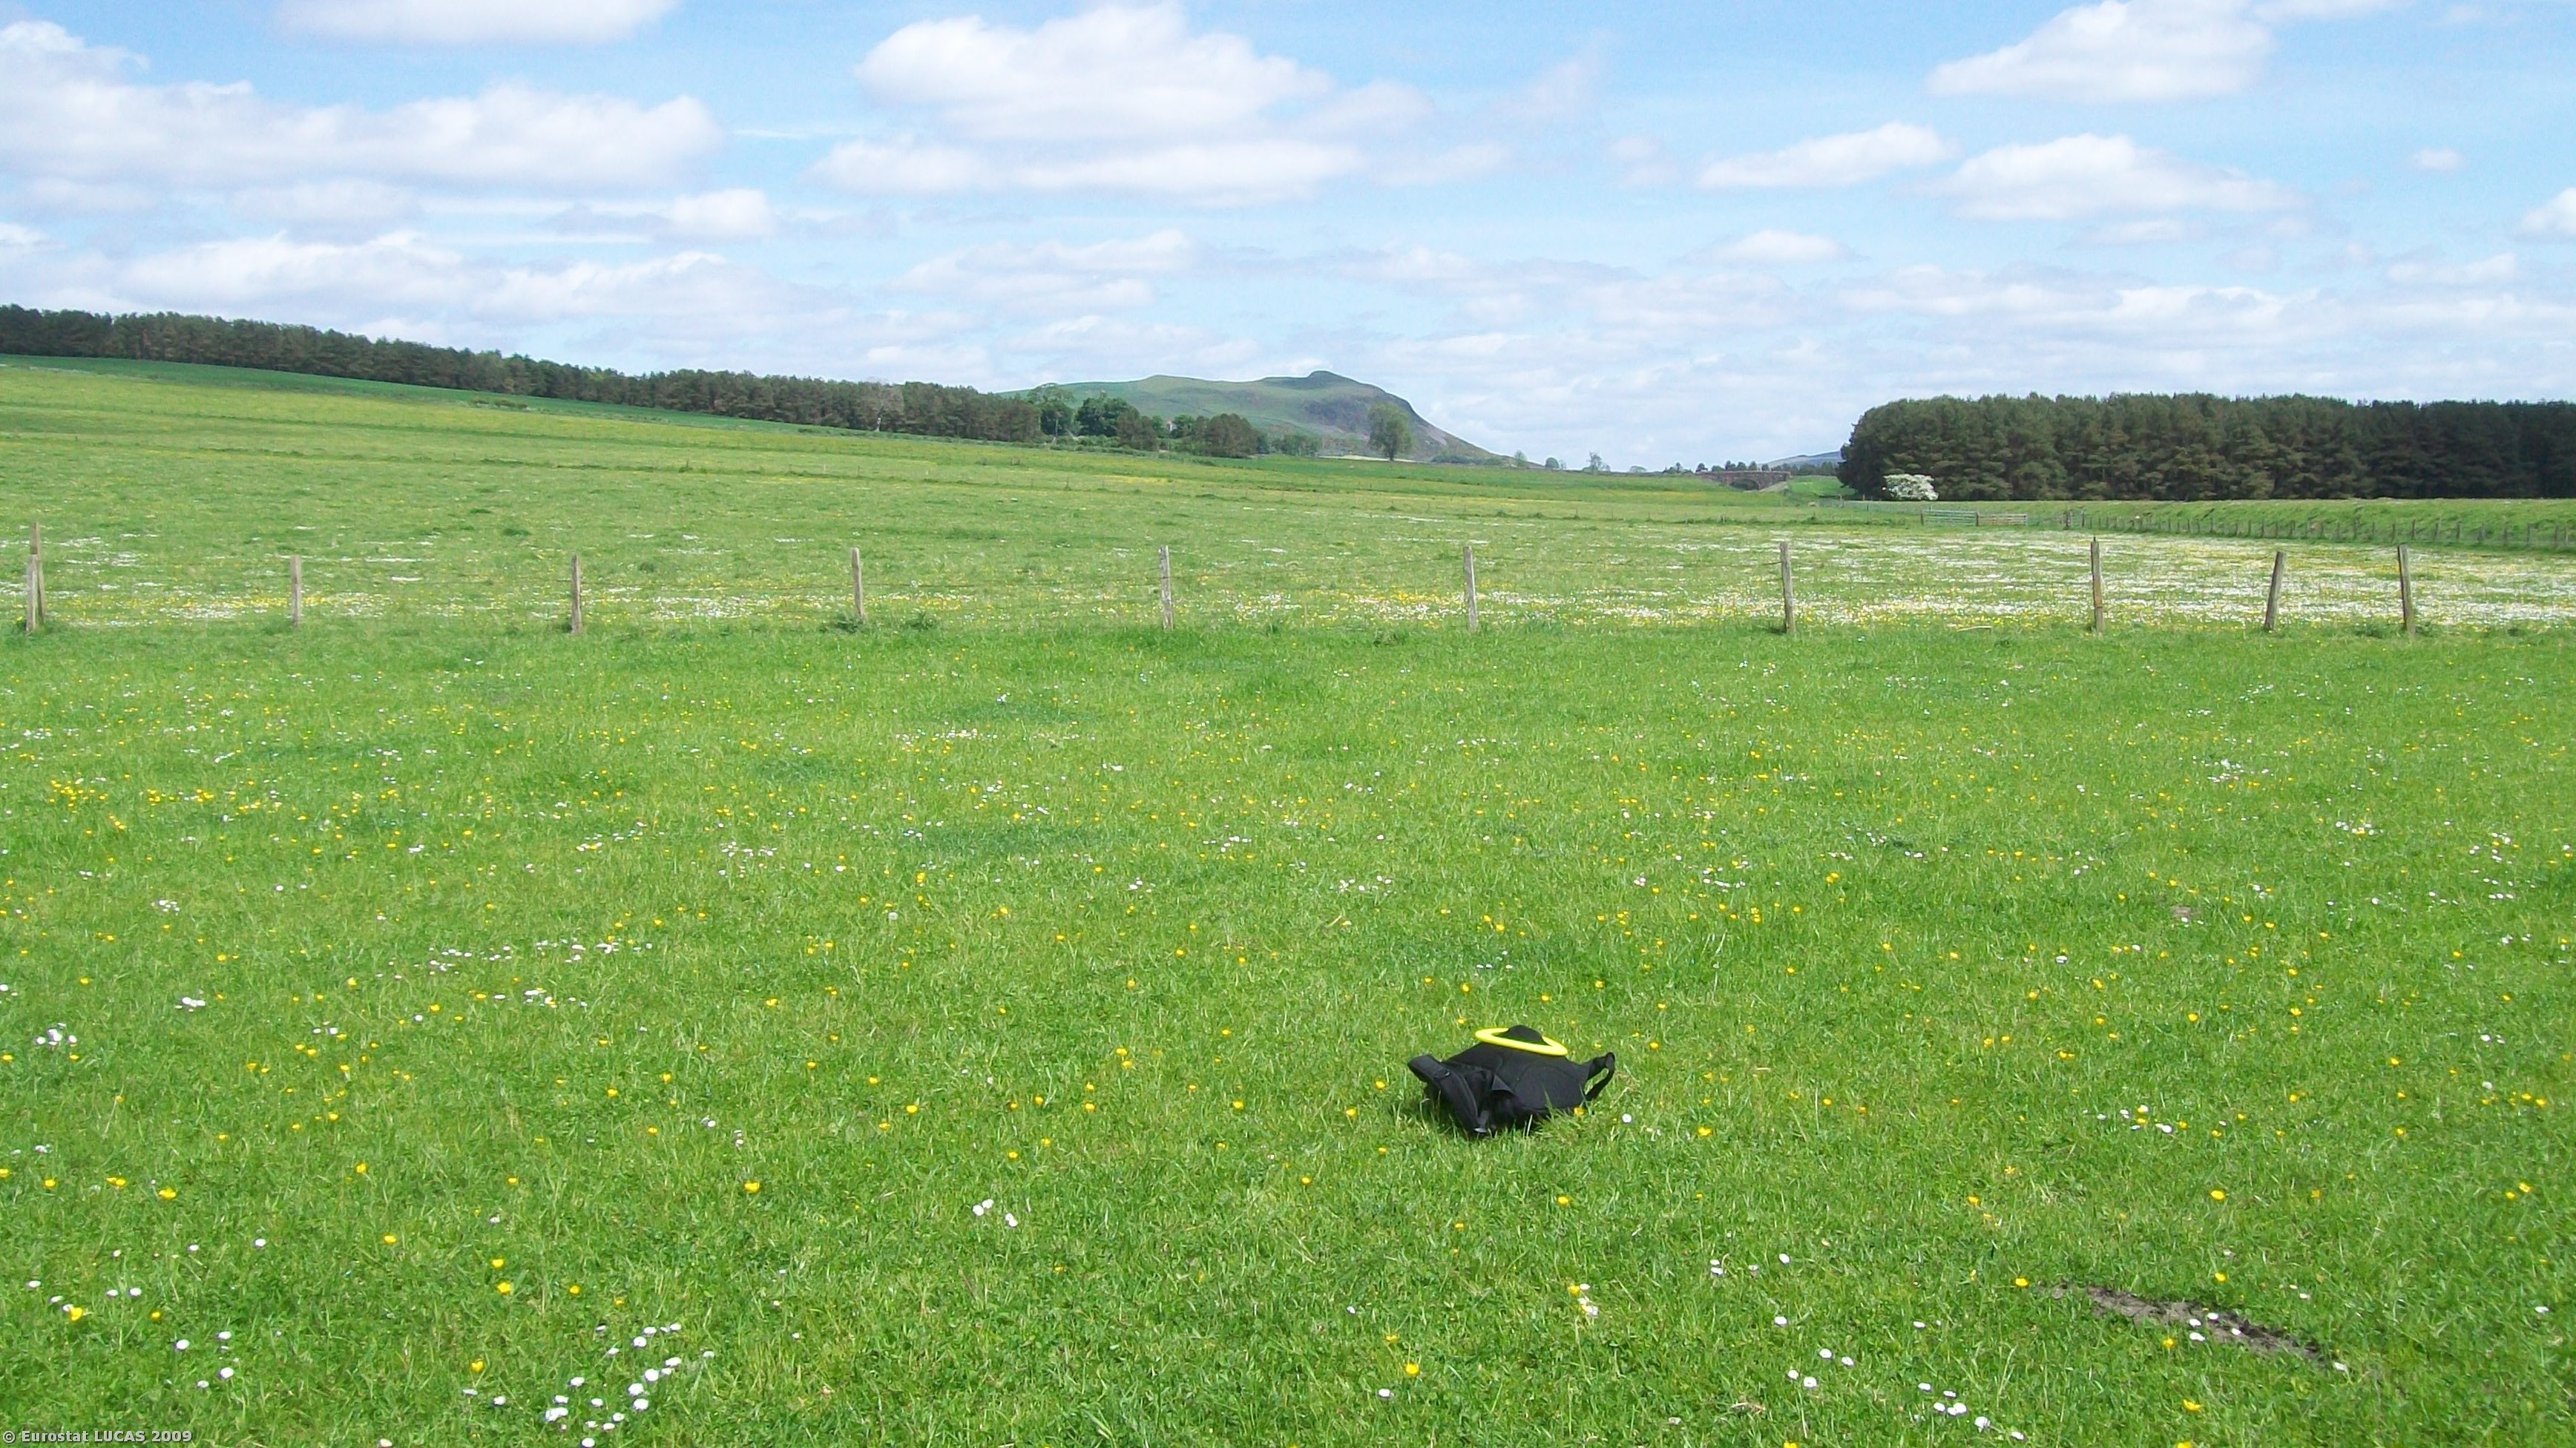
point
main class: Grassland
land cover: Grassland without tree/shrub cover
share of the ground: > 75 %
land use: Agriculture (excluding fallow land and kitchen gardens)
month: June
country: GB
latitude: 55.7045
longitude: -3.5256
